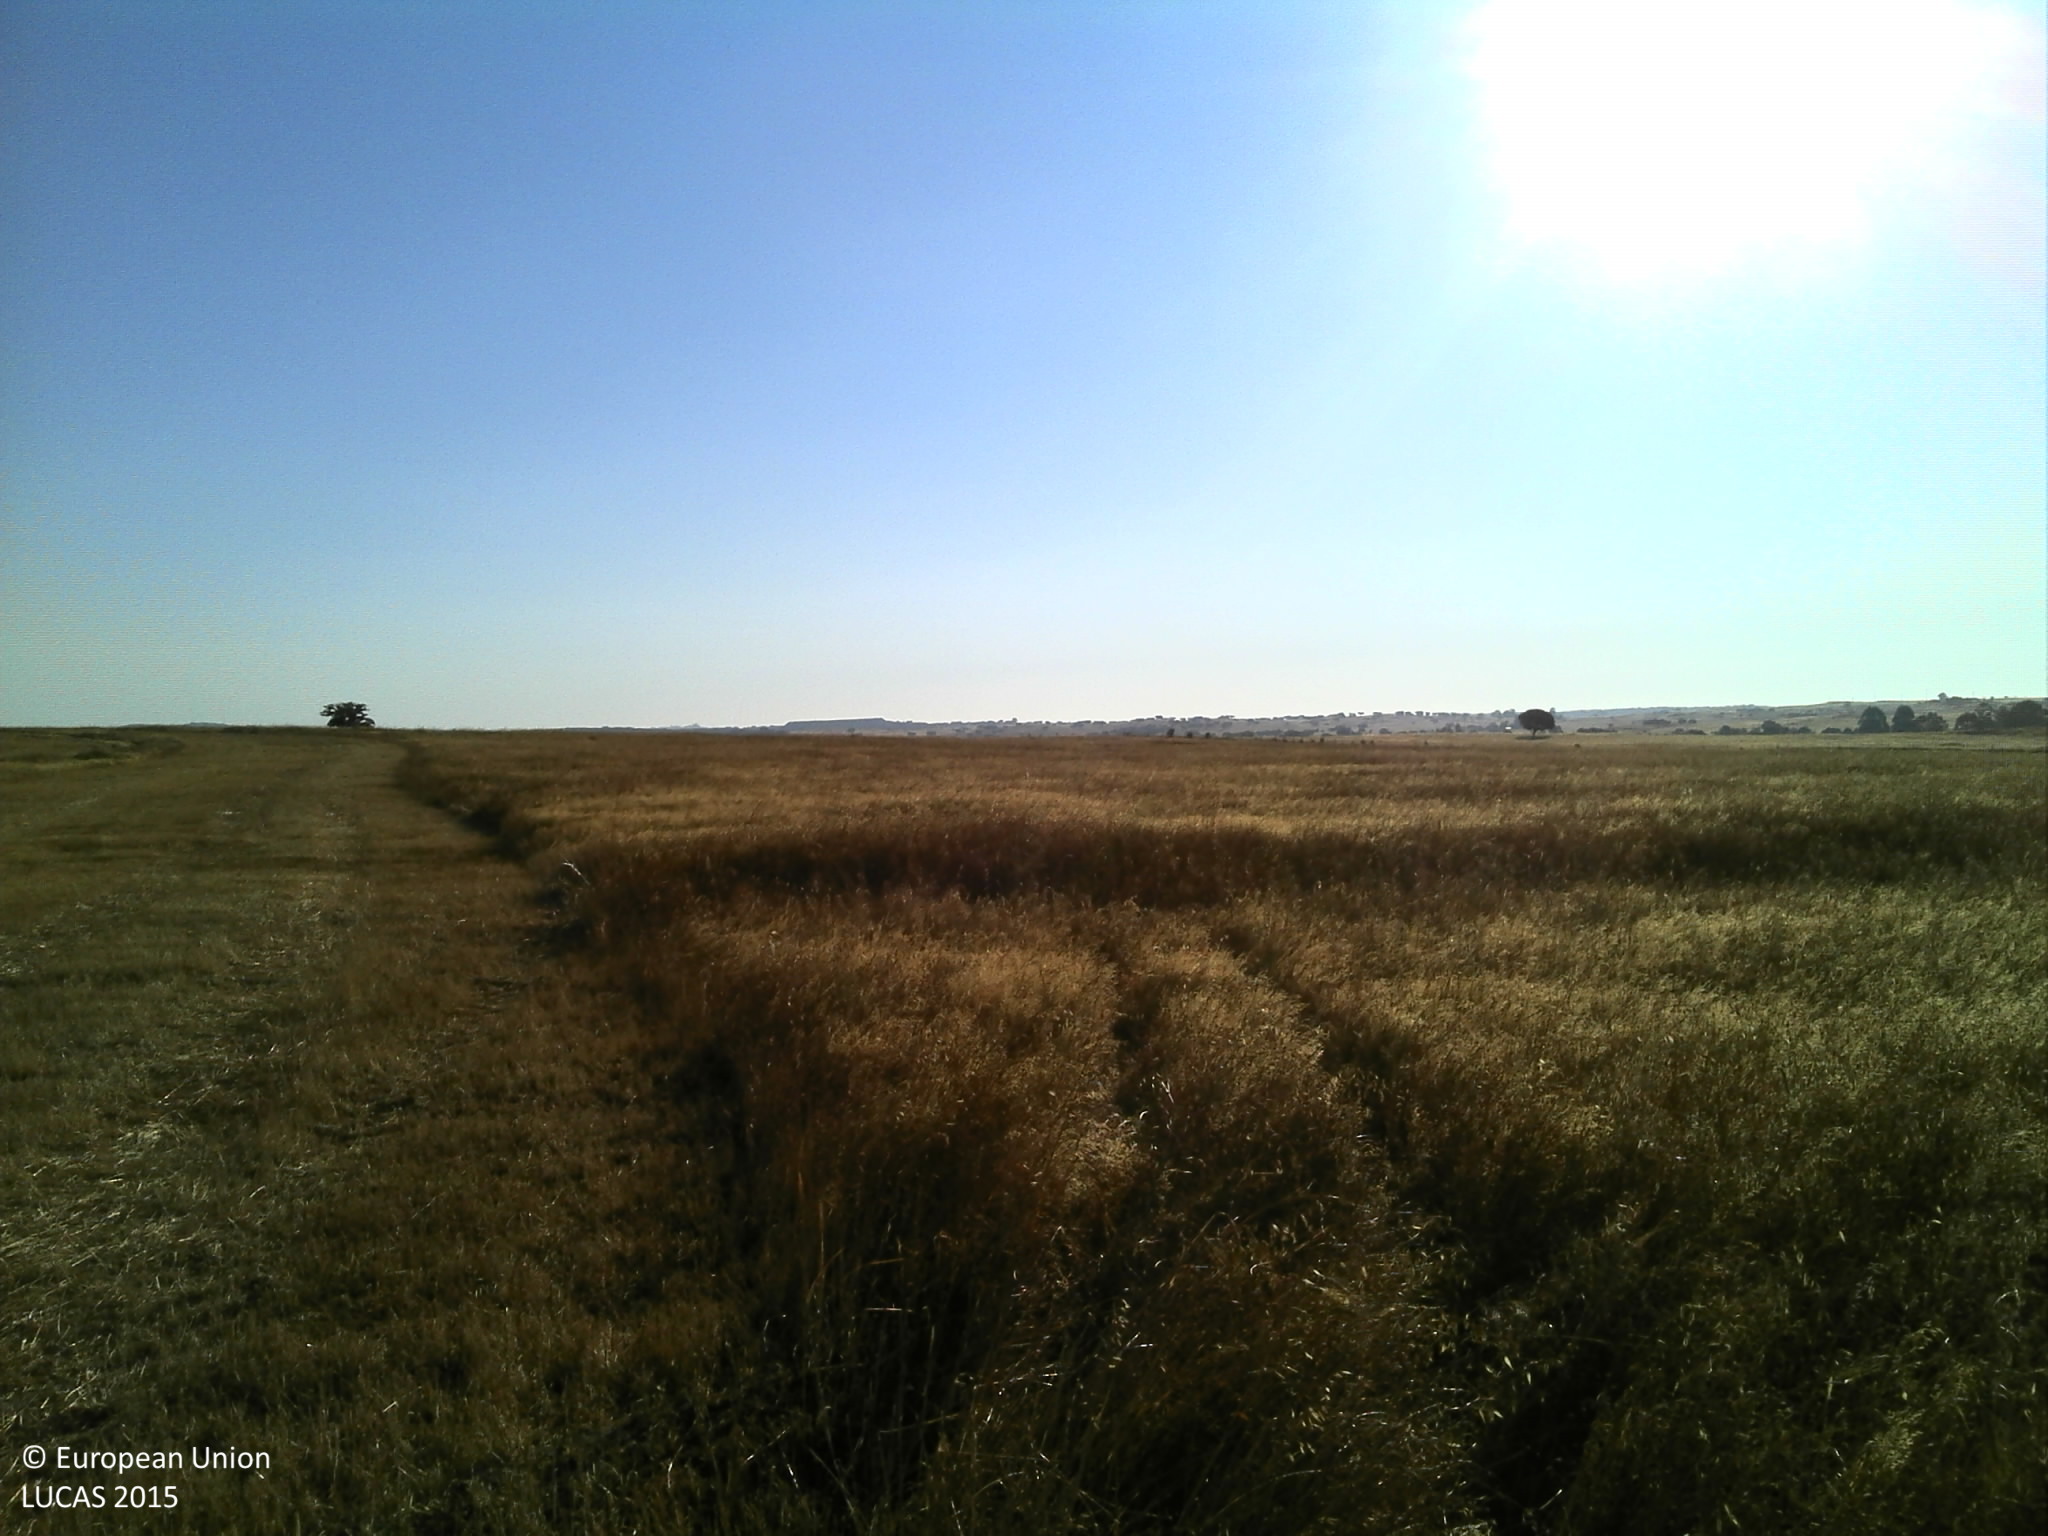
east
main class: Cropland
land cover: Oats
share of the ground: > 75 %
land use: Agriculture (excluding fallow land and kitchen gardens)
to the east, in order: Oats
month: June
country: PT
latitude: 38.4933
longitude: -8.0065
